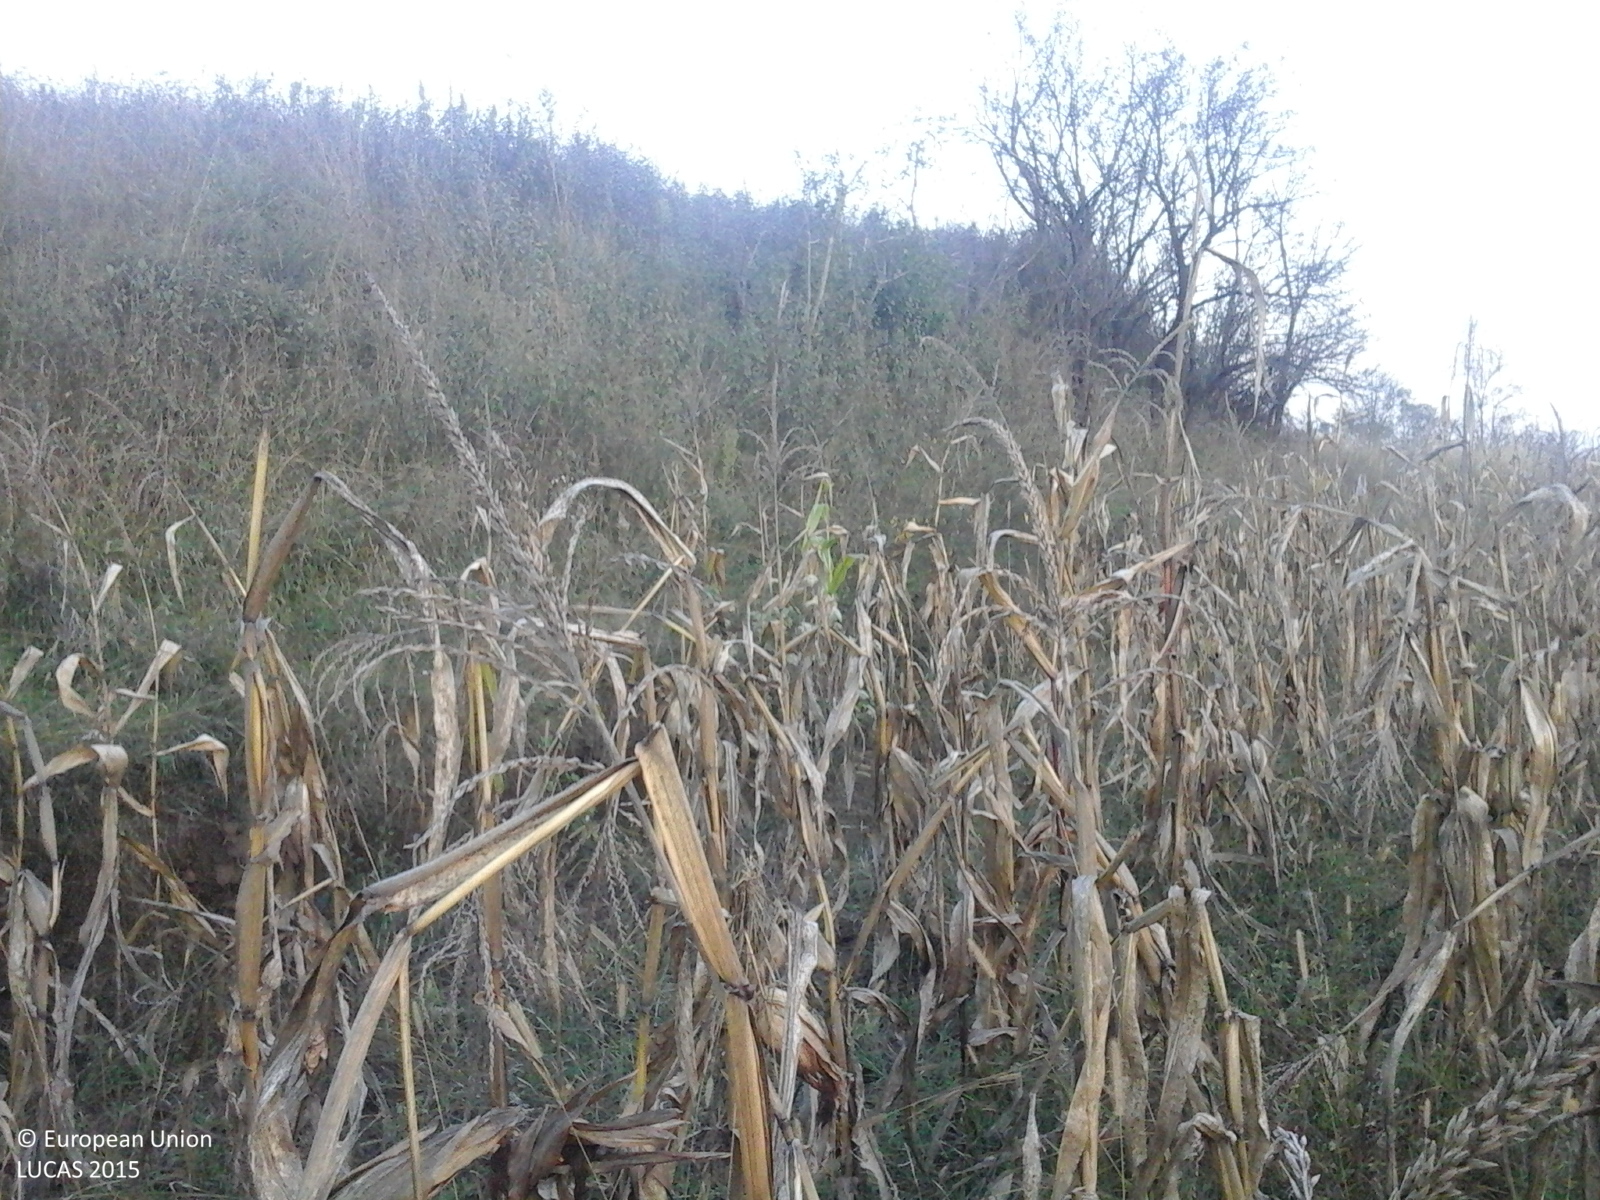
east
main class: Cropland
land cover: Maize
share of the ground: > 75 %
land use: Agriculture (excluding fallow land and kitchen gardens)
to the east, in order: Maize; Grassland without tree/shrub cover; Maize; Grassland without tree/shrub cover
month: October
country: RO
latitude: 46.0234
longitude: 24.1703
